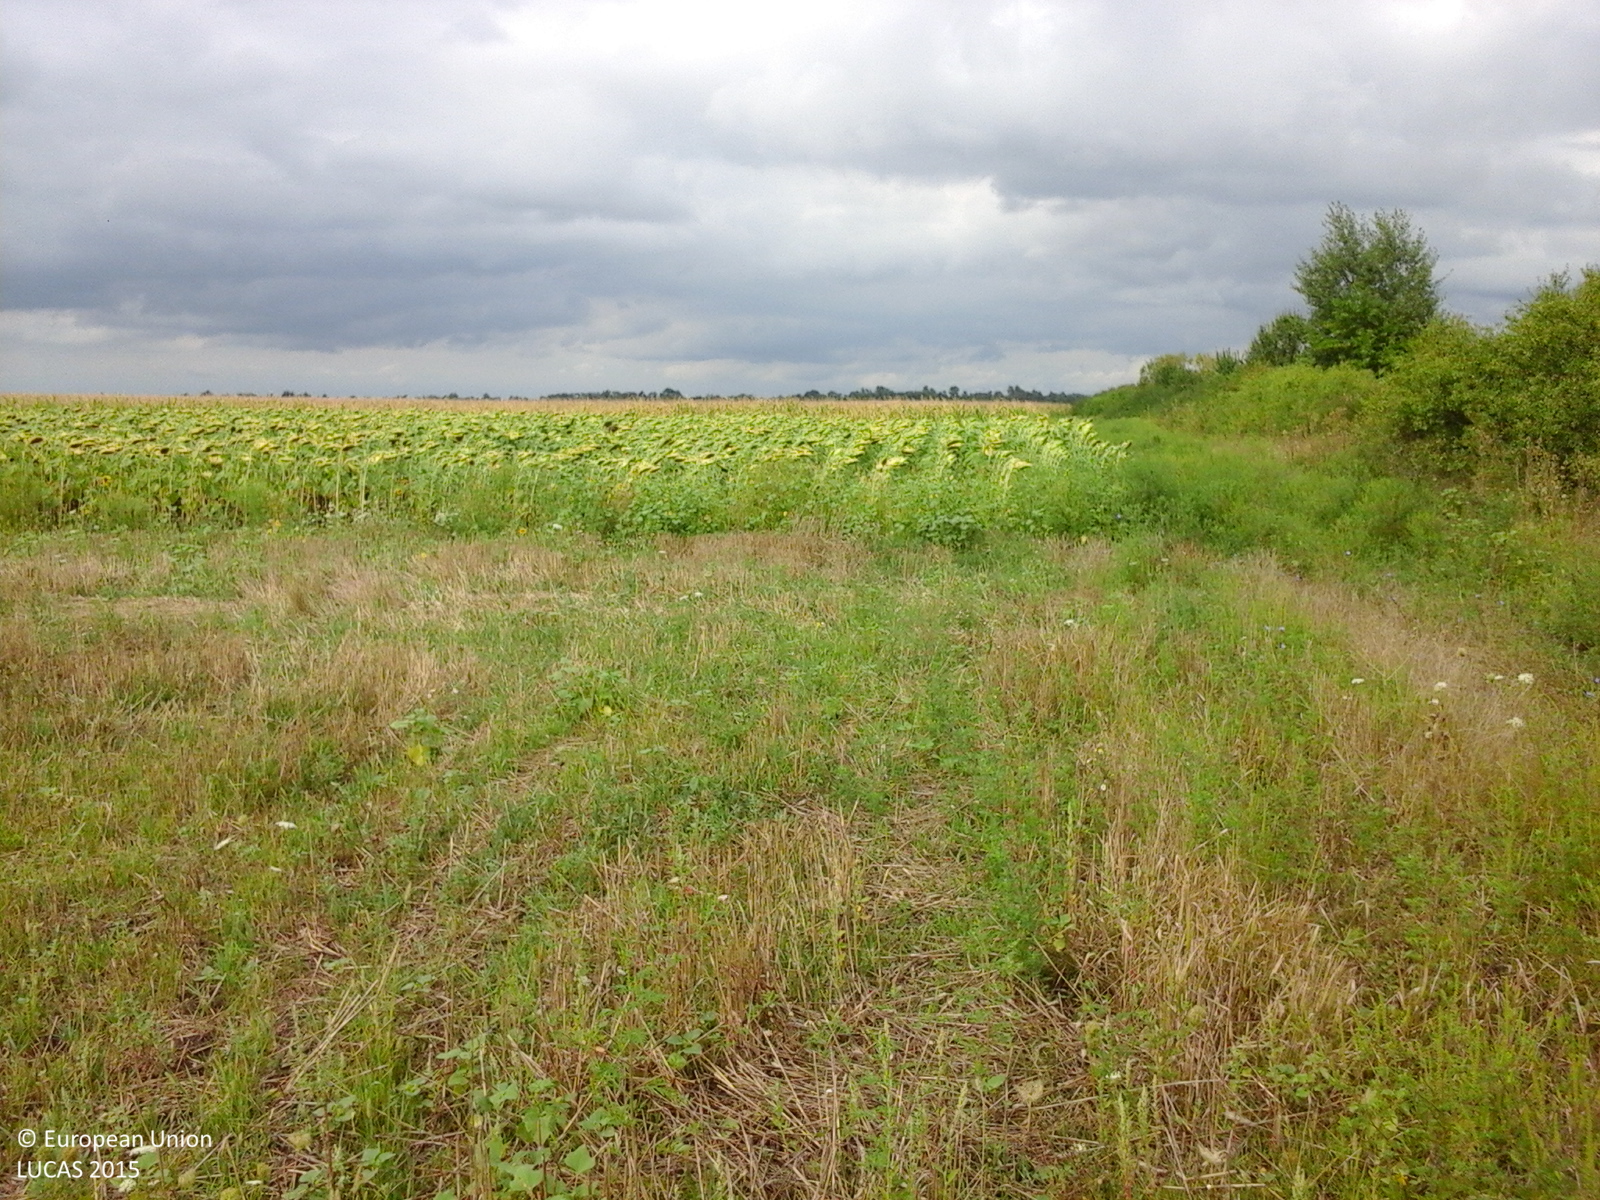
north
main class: Cropland
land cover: Common wheat
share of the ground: 10 - 25 %
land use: Agriculture (excluding fallow land and kitchen gardens)
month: August
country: RO
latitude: 45.7717
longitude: 21.4396
